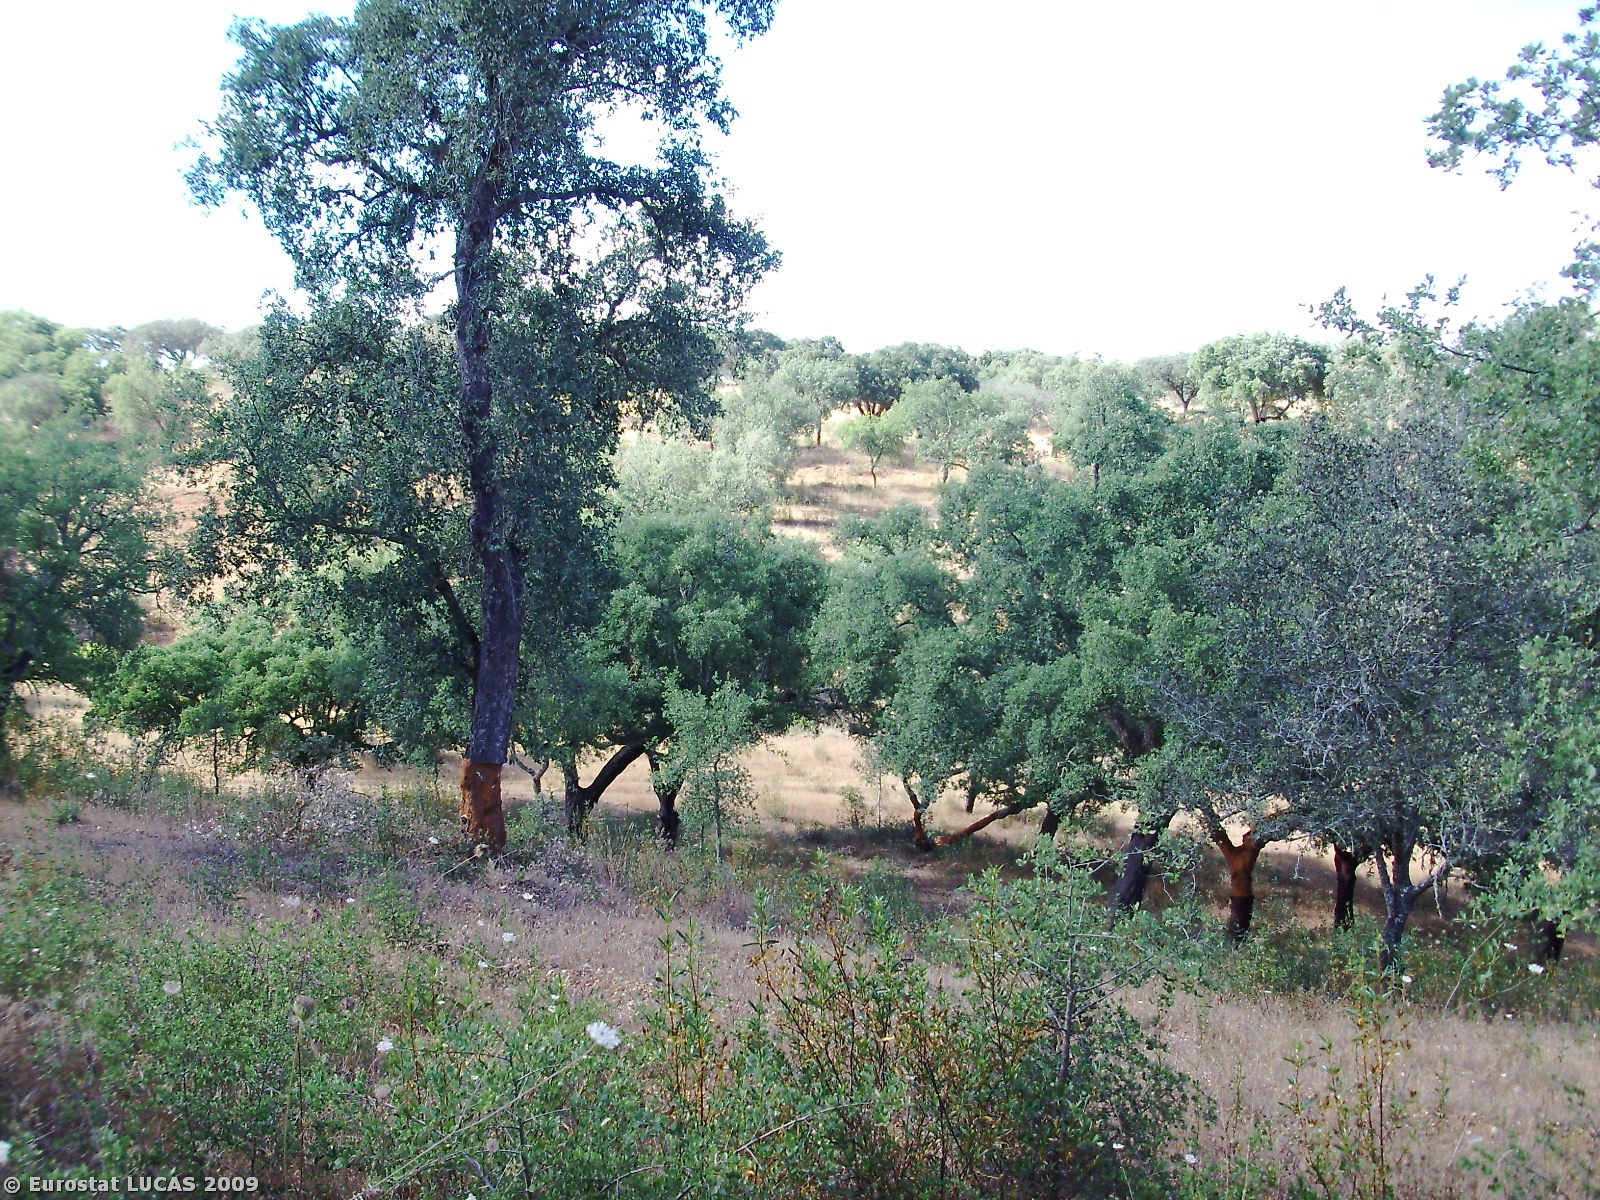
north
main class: Woodland
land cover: Broadleaved woodland
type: broadleaved evergreen forest
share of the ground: 10 - 25 %
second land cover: Shrubland with sparse tree cover
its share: 25 - 50 %
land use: Forestry
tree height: > 5 m
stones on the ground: 25 - 50 %
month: June
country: PT
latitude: 37.8019
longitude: -8.5179
